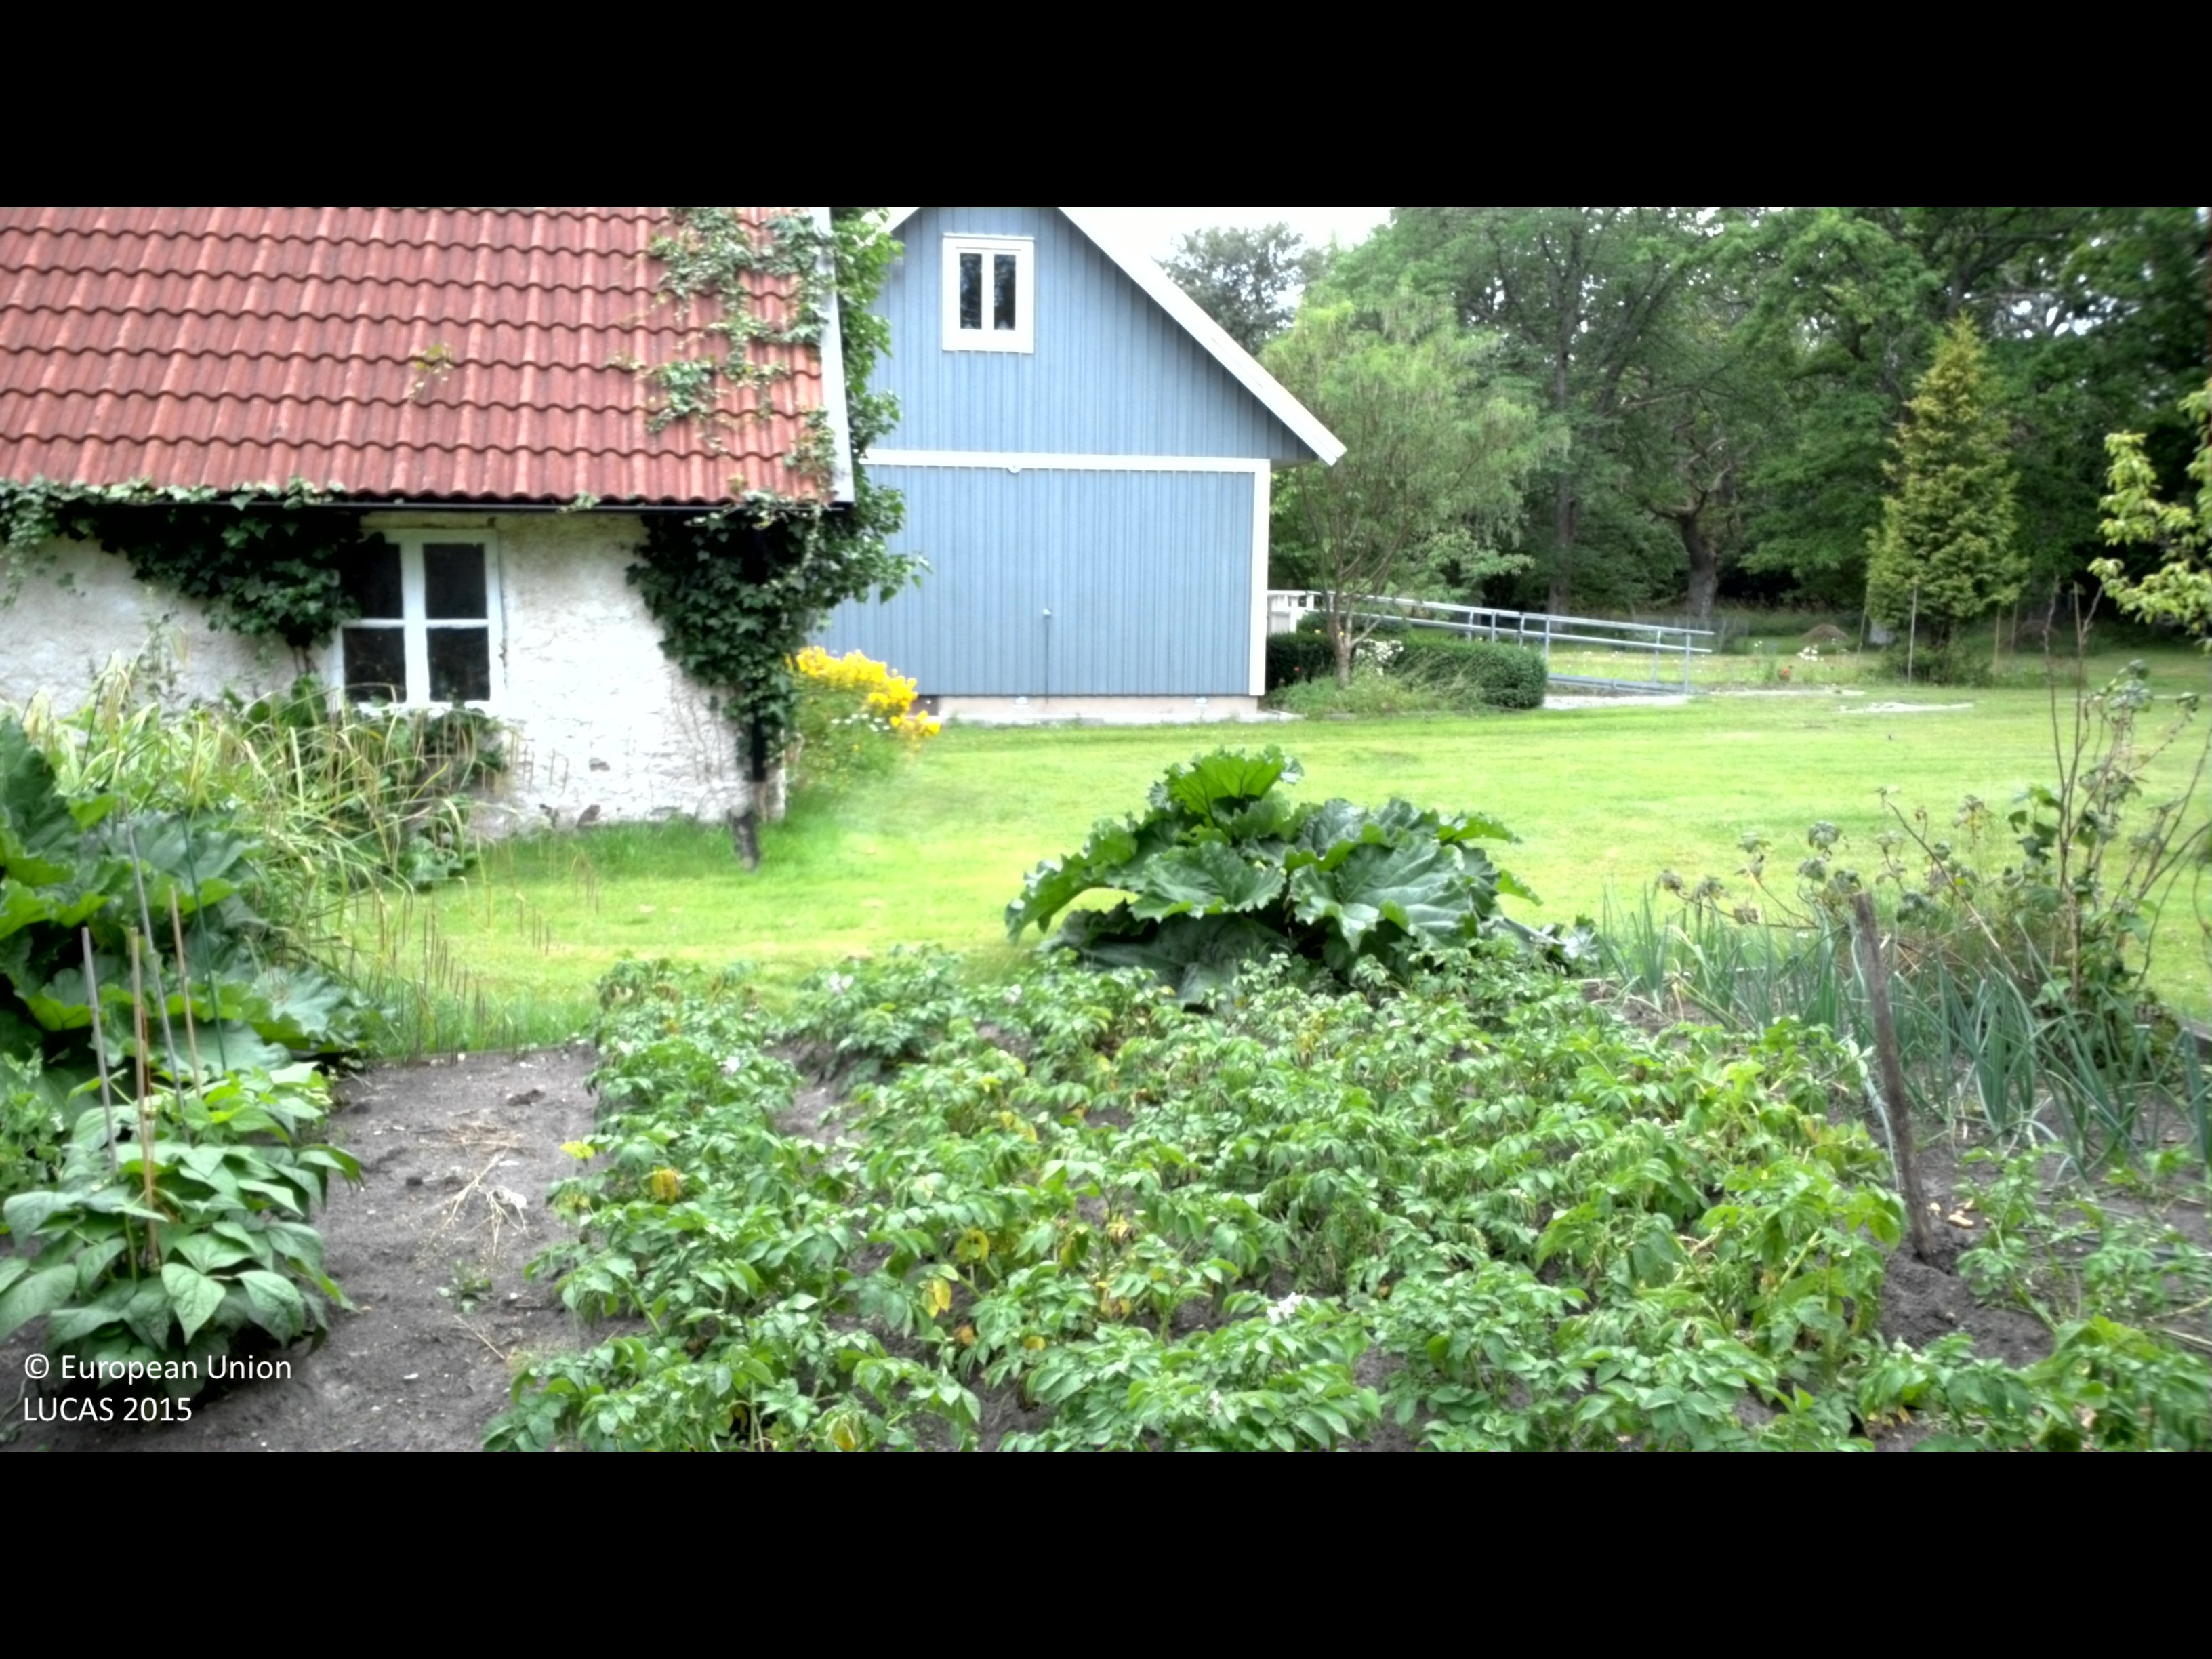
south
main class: Woodland
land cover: Broadleaved woodland
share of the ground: 10 - 25 %
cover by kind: herbaceous plants 75 %, broadleaved forest trees 25 %
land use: Residential
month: July
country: SE
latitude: 57.0844
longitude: 16.9153
